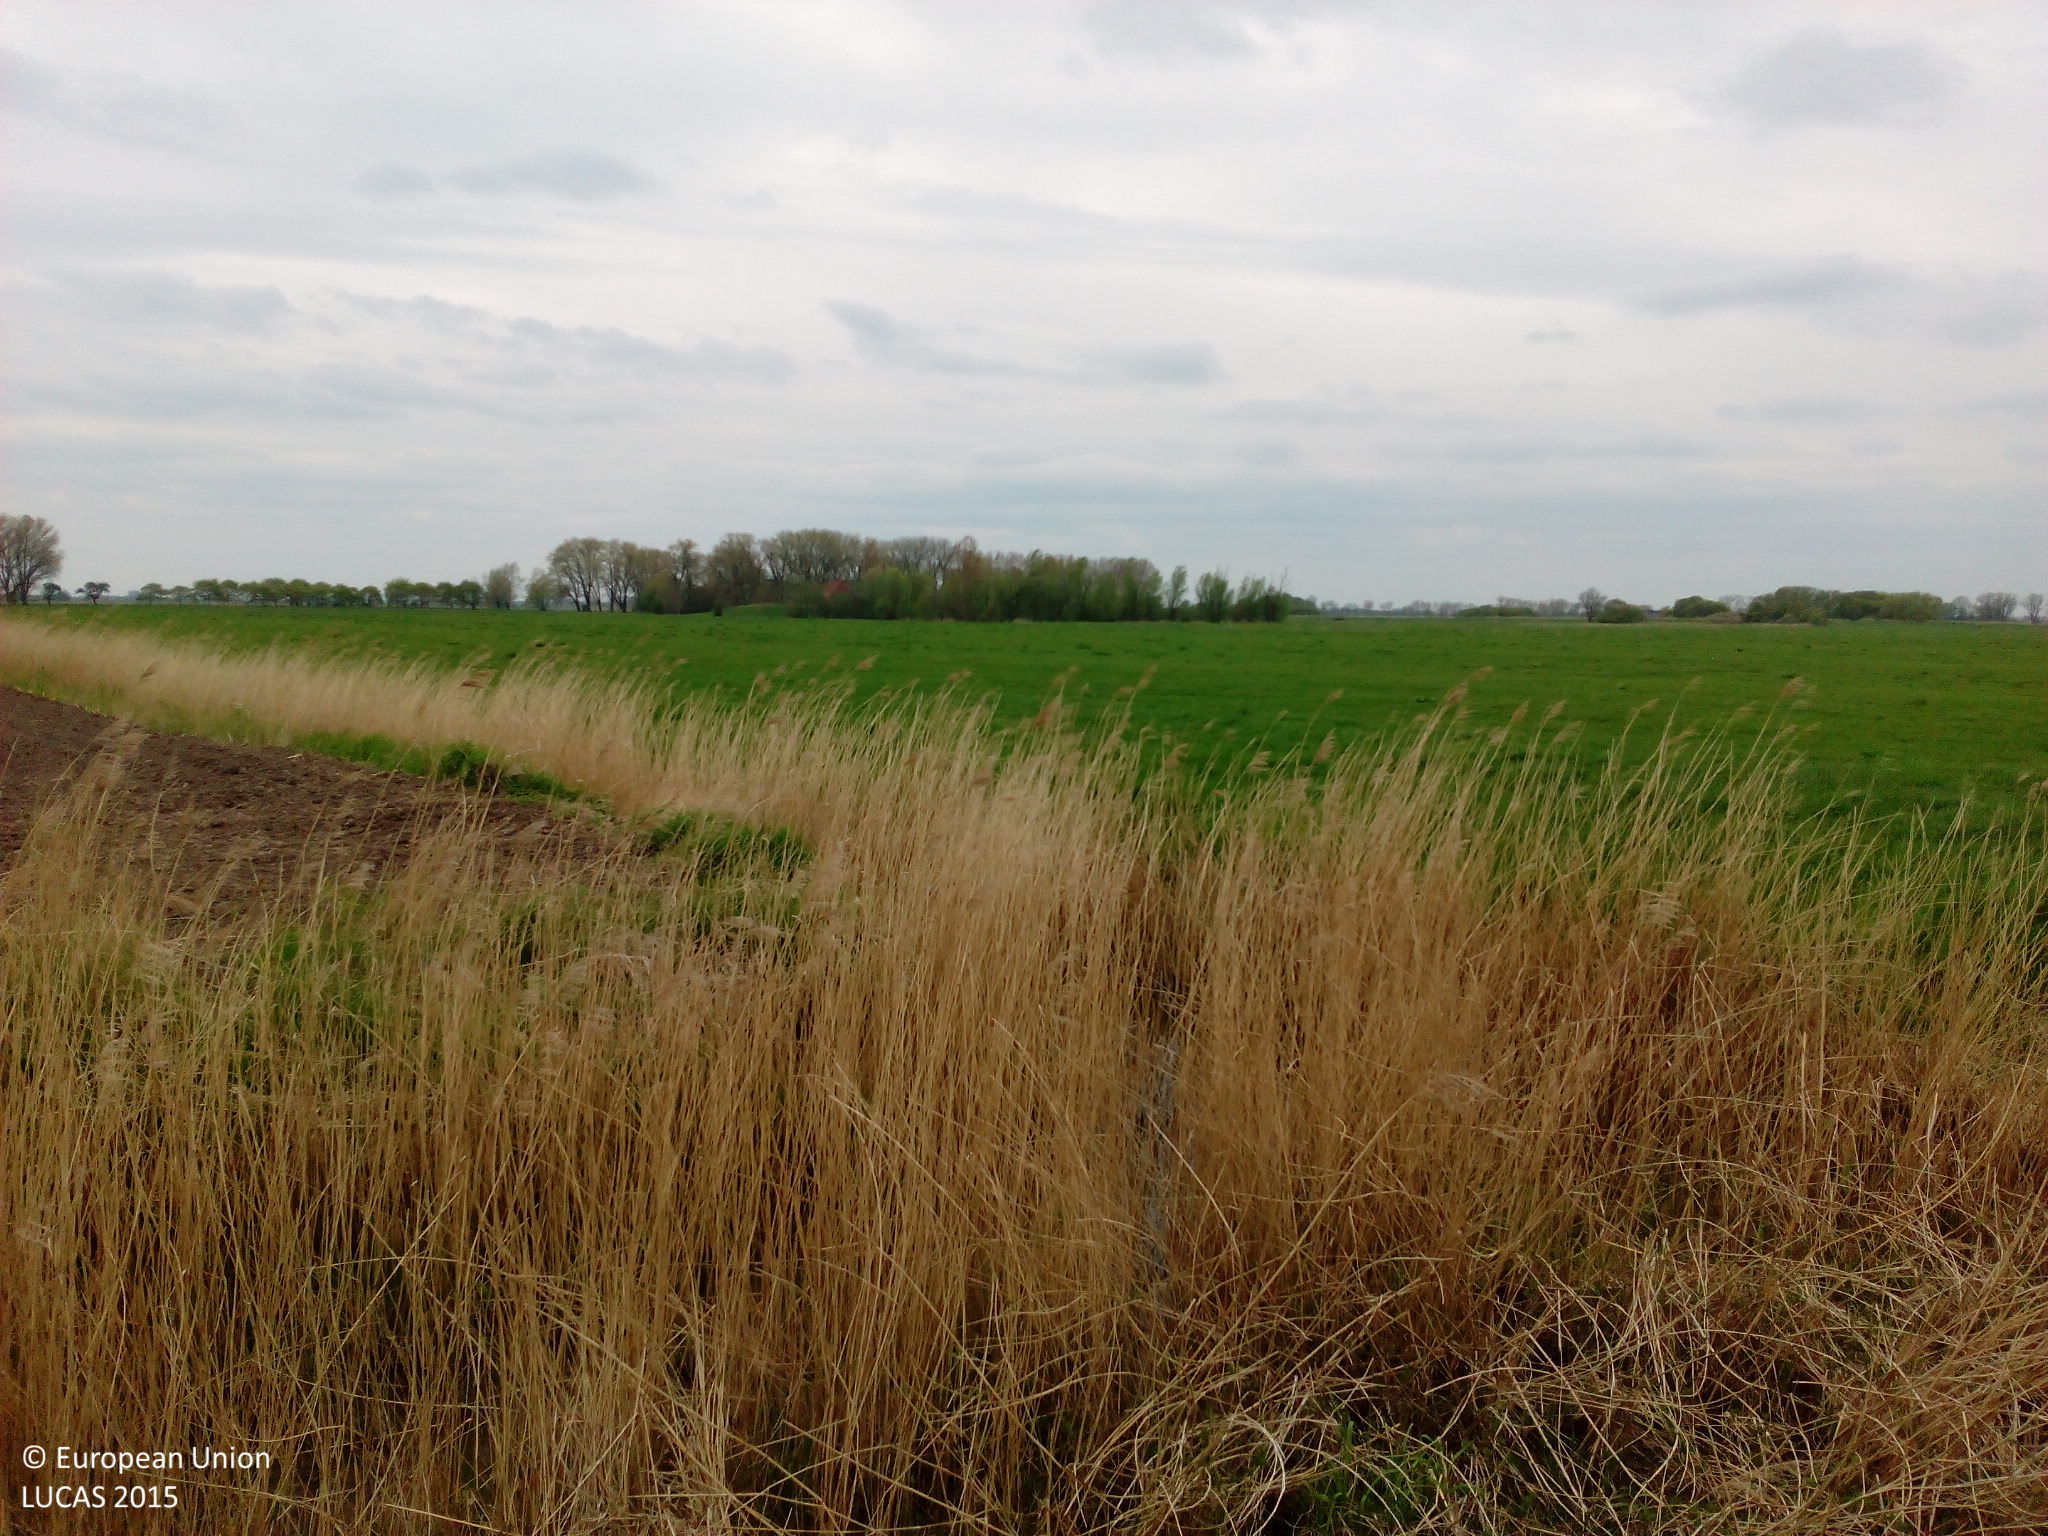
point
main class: Grassland
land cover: Grassland without tree/shrub cover
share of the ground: > 75 %
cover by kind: herbaceous plants 100 %
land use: Agriculture (excluding fallow land and kitchen gardens)
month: May
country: DE
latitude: 53.2850
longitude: 8.5156
